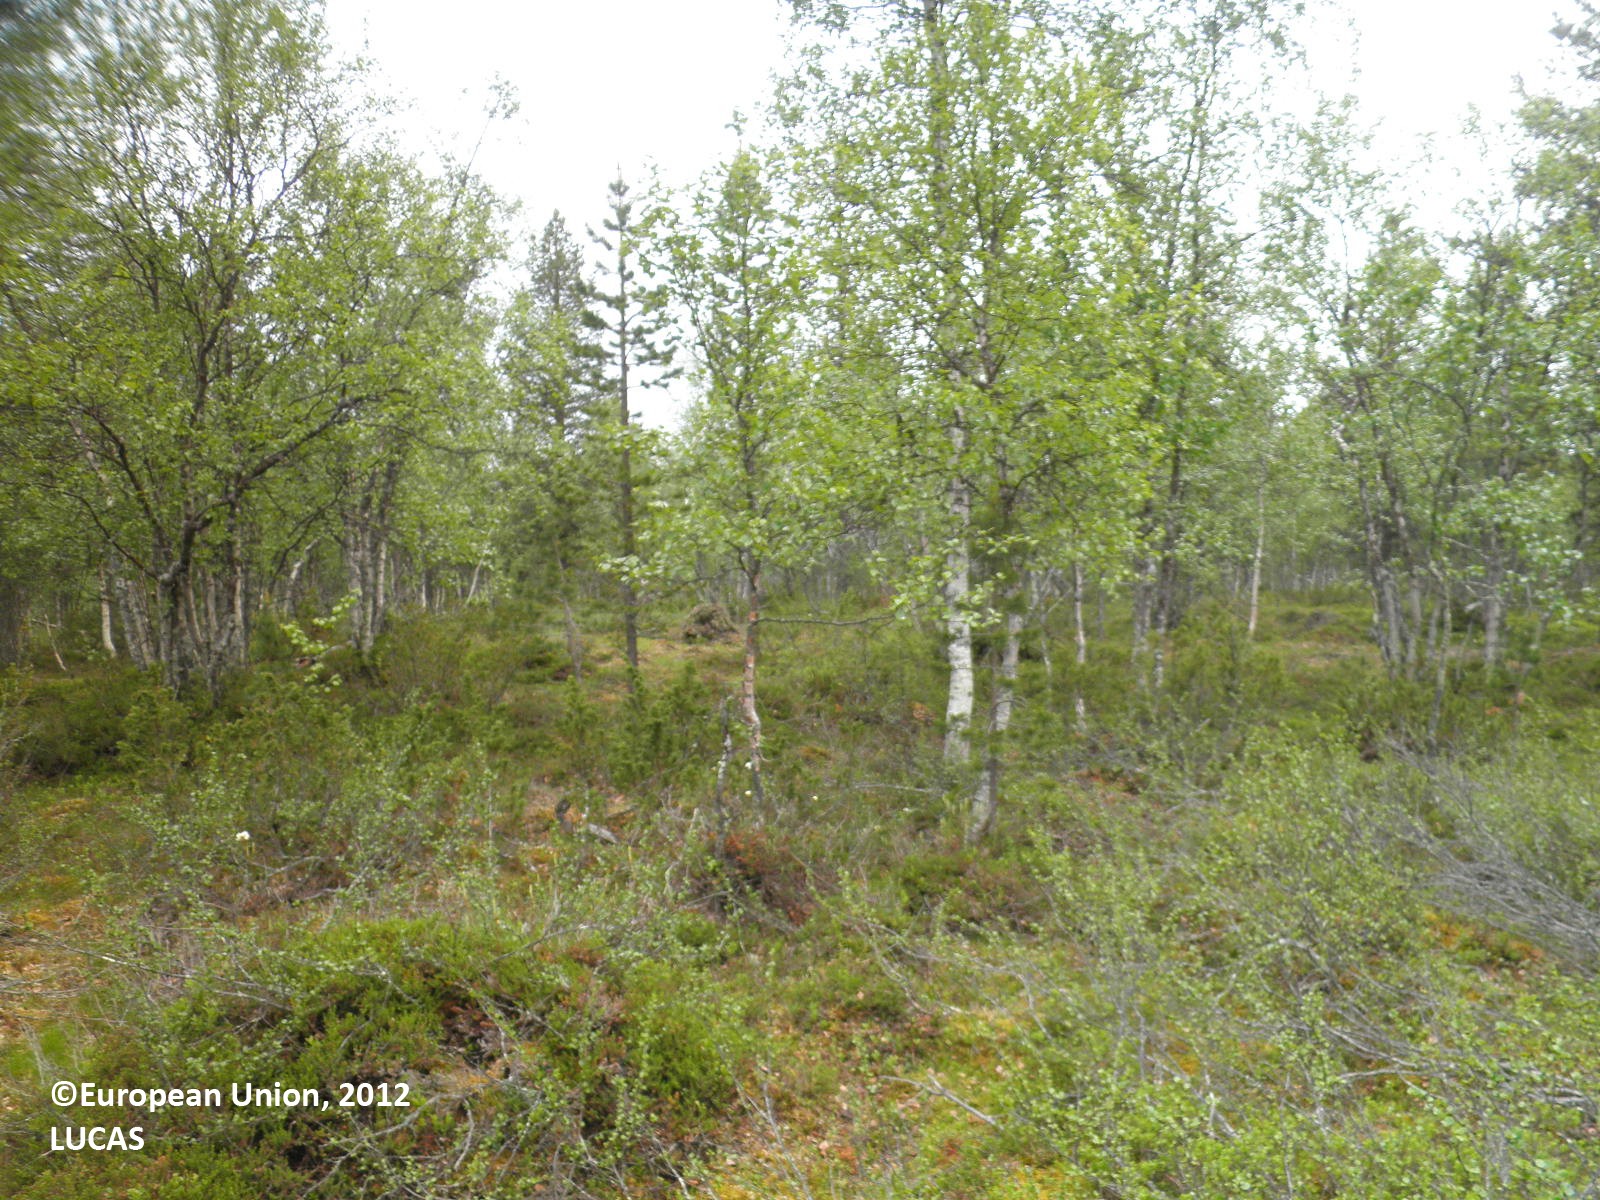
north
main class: Woodland
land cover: Pine dominated mixed woodland
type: boreal forest
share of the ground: 50 - 75 %
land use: Forestry
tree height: > 5 m
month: July
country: FI
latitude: 68.4001
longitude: 25.6406
